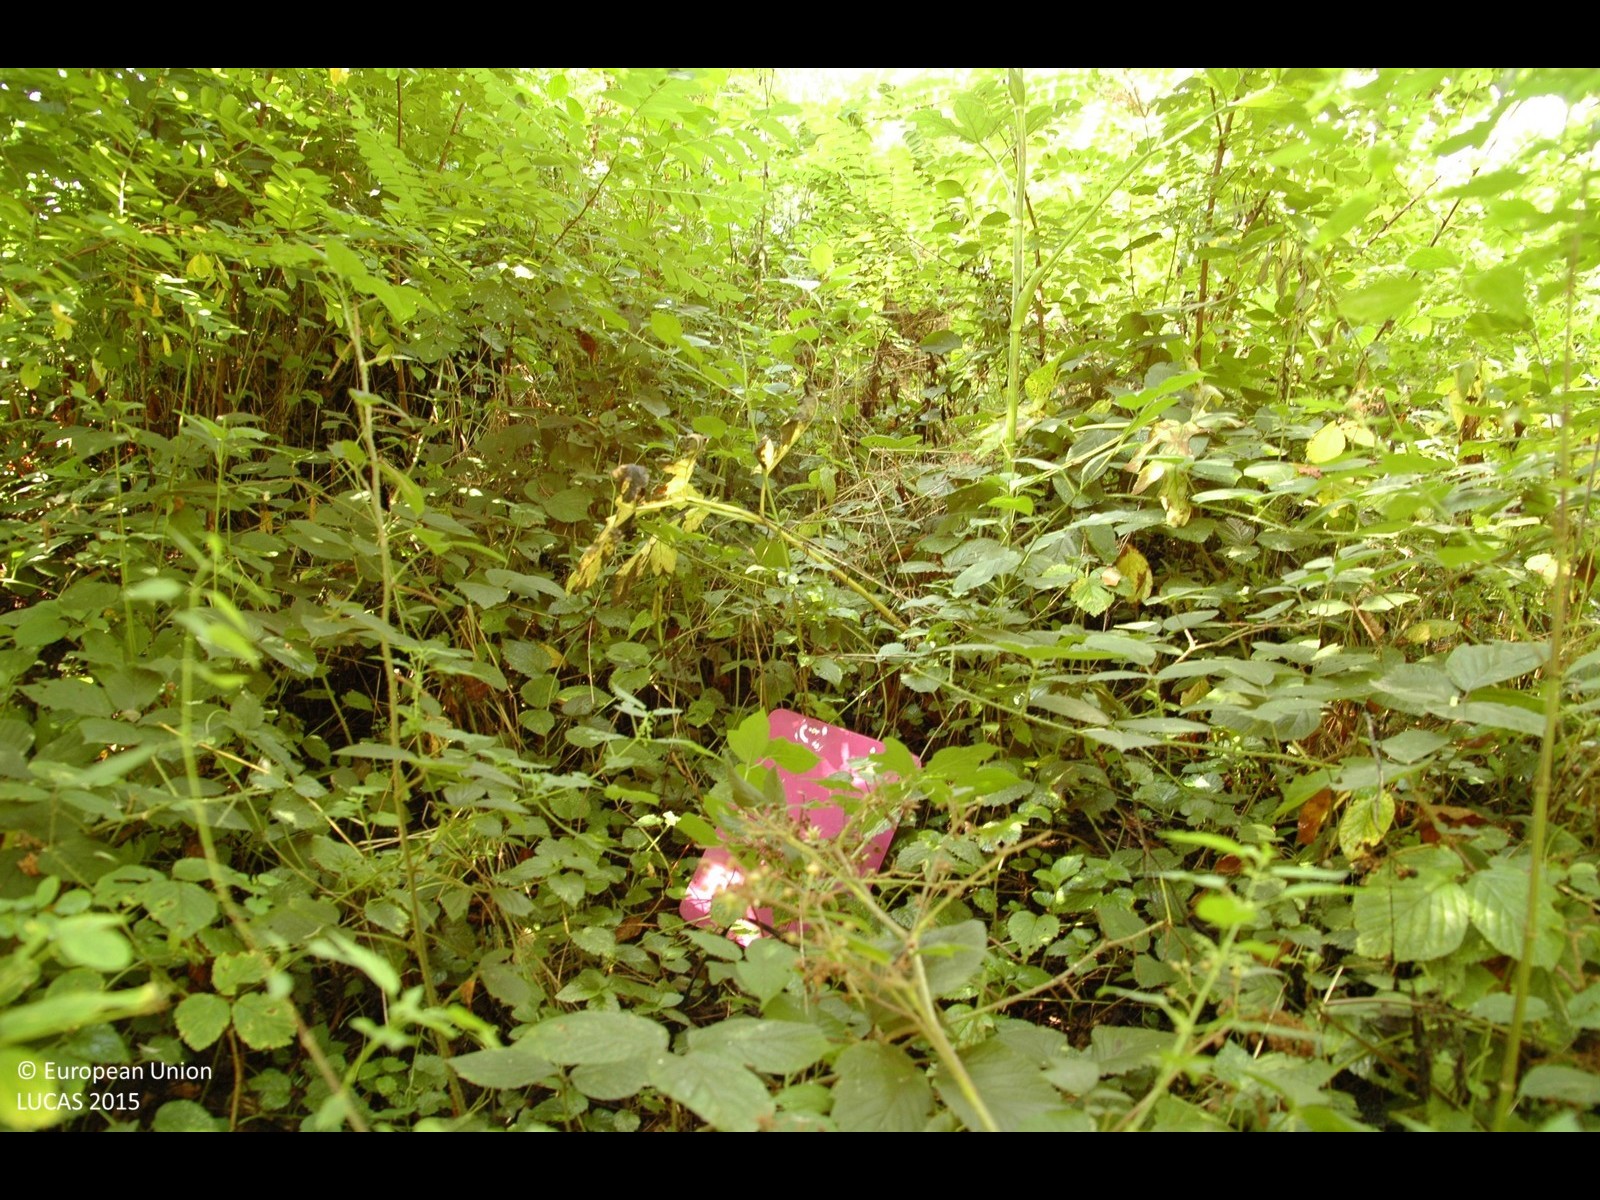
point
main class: Woodland
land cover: Broadleaved woodland
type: mesophytic deciduous forest
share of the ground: > 75 %
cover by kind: broadleaved forest trees 100 %
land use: Forestry
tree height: > 5 m
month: August
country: HR
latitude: 45.8584
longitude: 15.9870
